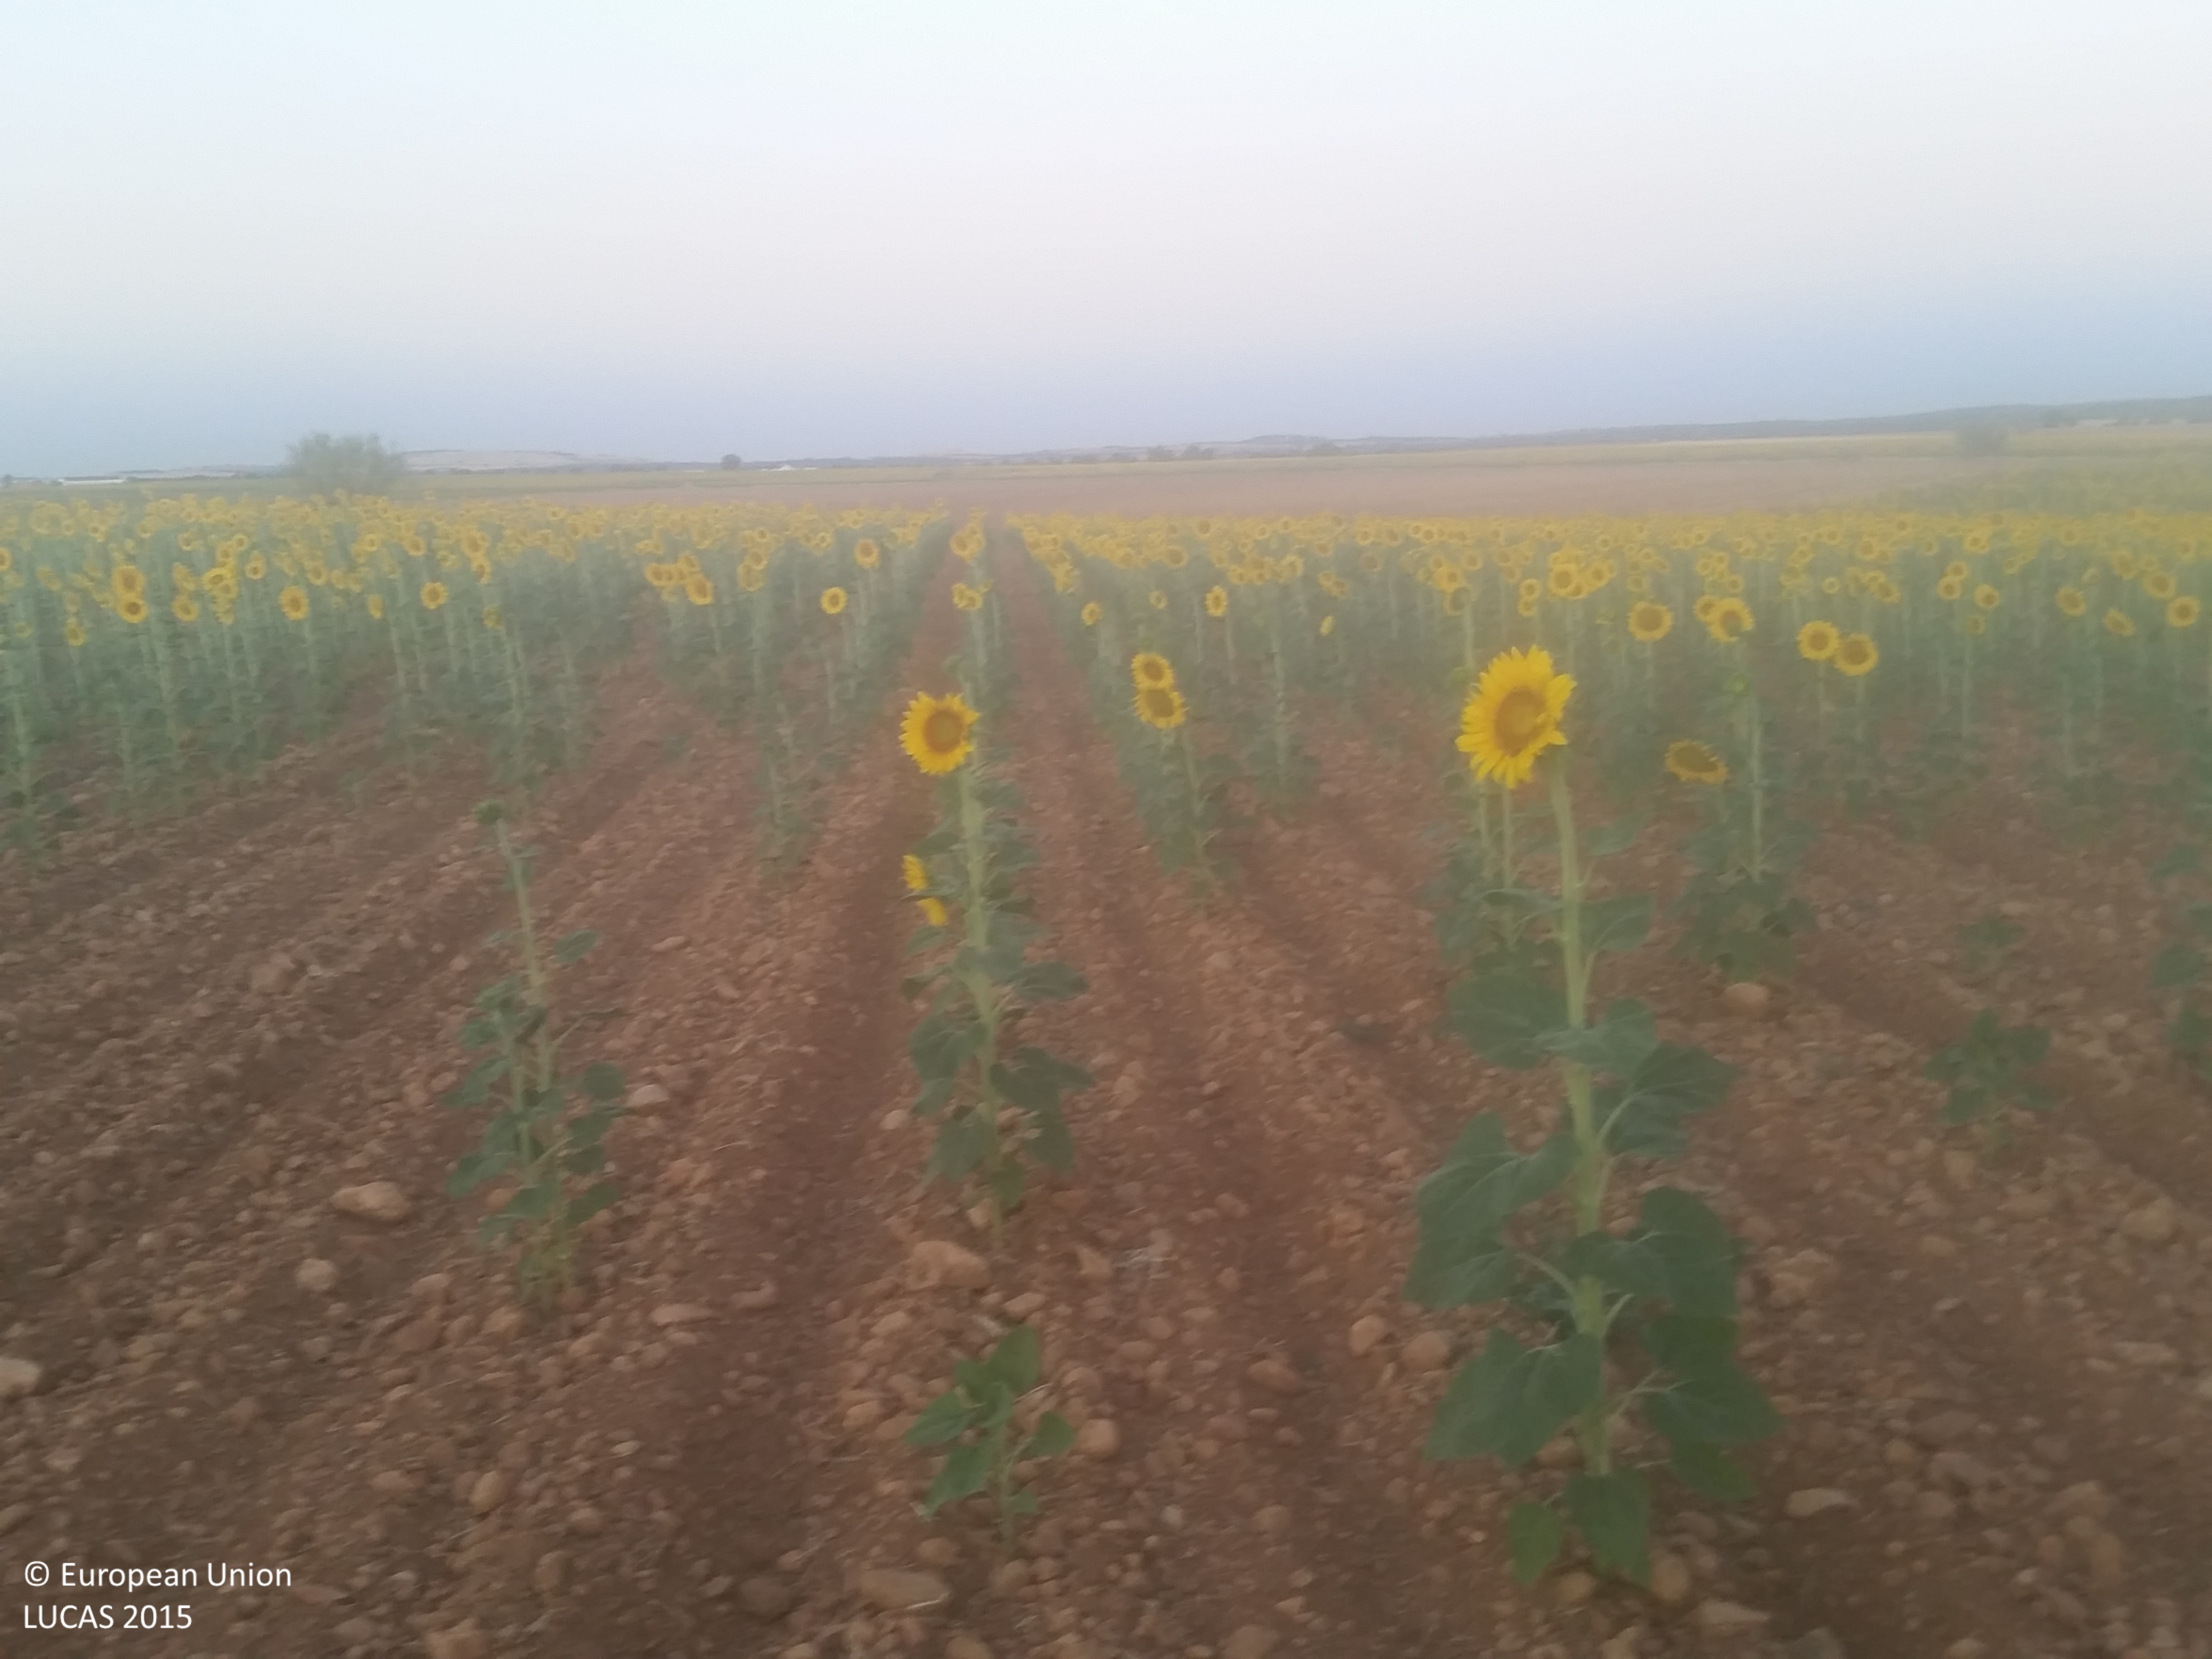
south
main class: Cropland
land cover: Sunflower
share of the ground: > 75 %
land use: Agriculture (excluding fallow land and kitchen gardens)
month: July
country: ES
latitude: 39.1365
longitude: -2.6303
